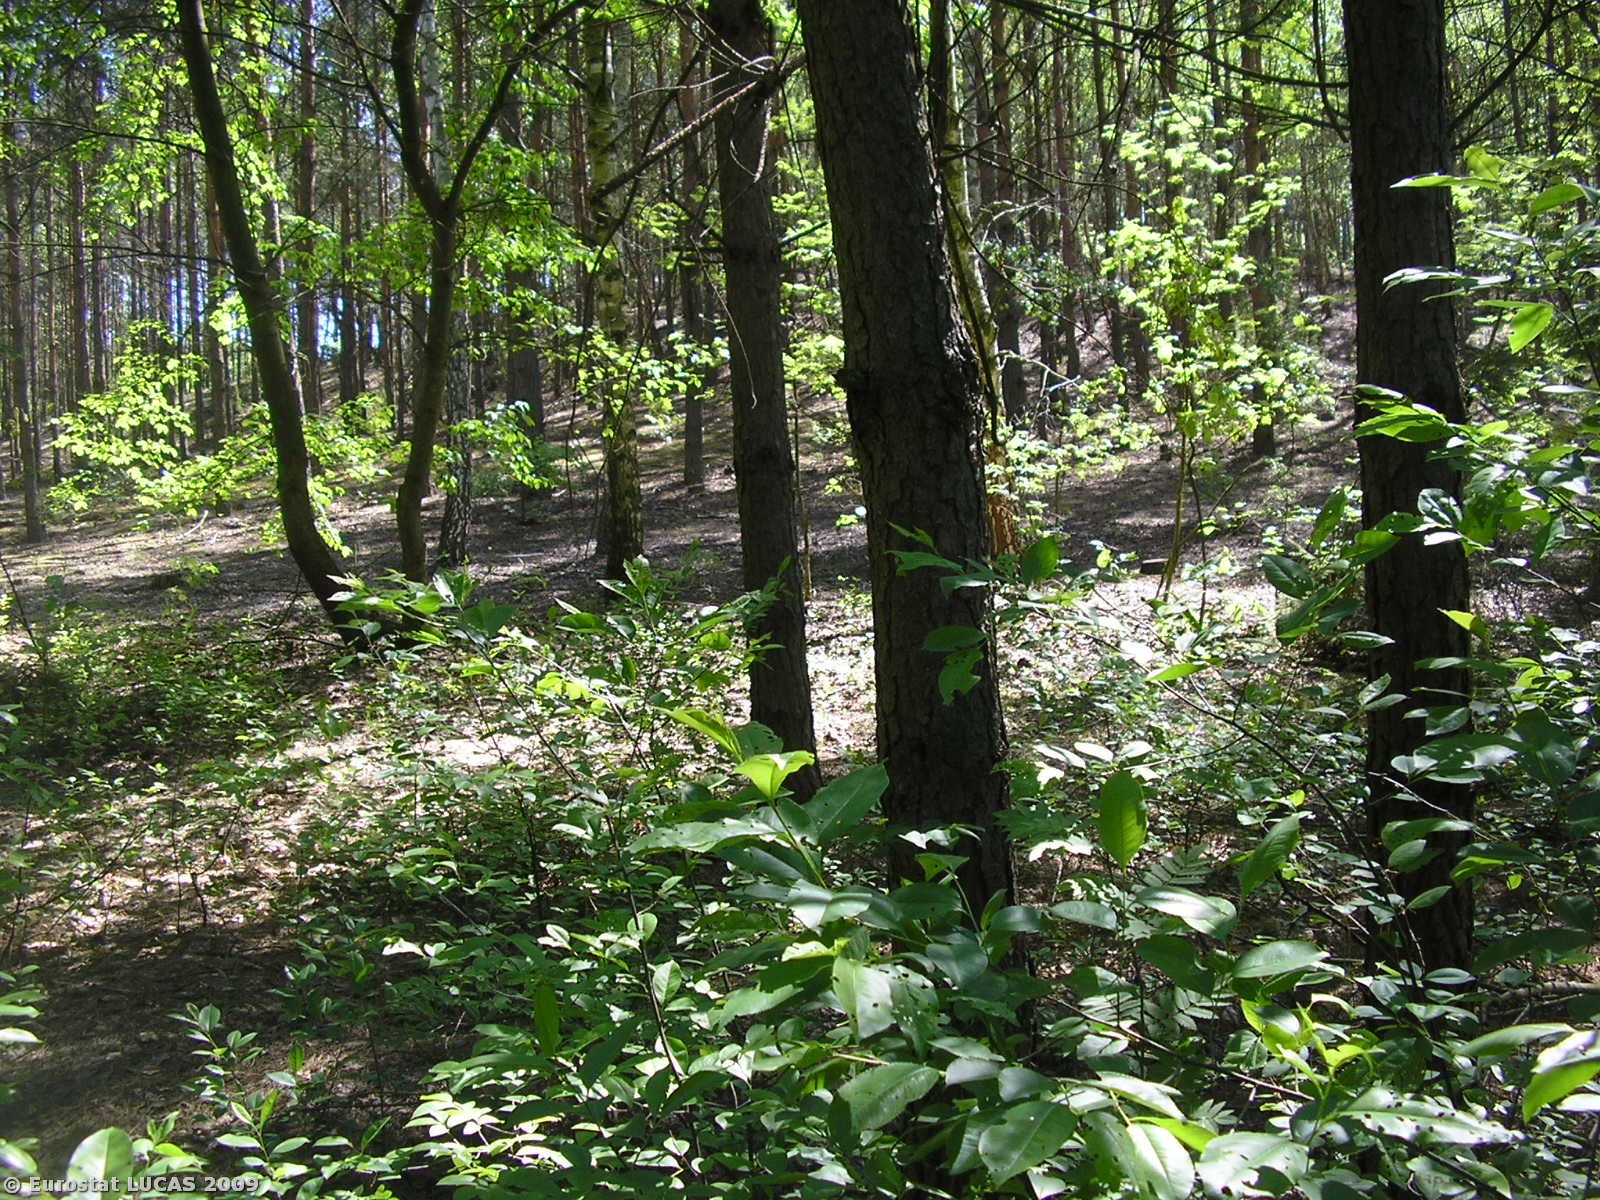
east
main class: Woodland
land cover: Mixed woodland
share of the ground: > 75 %
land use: Forestry
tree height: > 5 m
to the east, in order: Mixed woodland; Broadleaved woodland; Tracks; Broadleaved woodland; Mixed woodland; Broadleaved woodland; Tracks; Fences; Broadleaved woodland
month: May
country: PL
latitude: 51.7310
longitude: 20.0675
